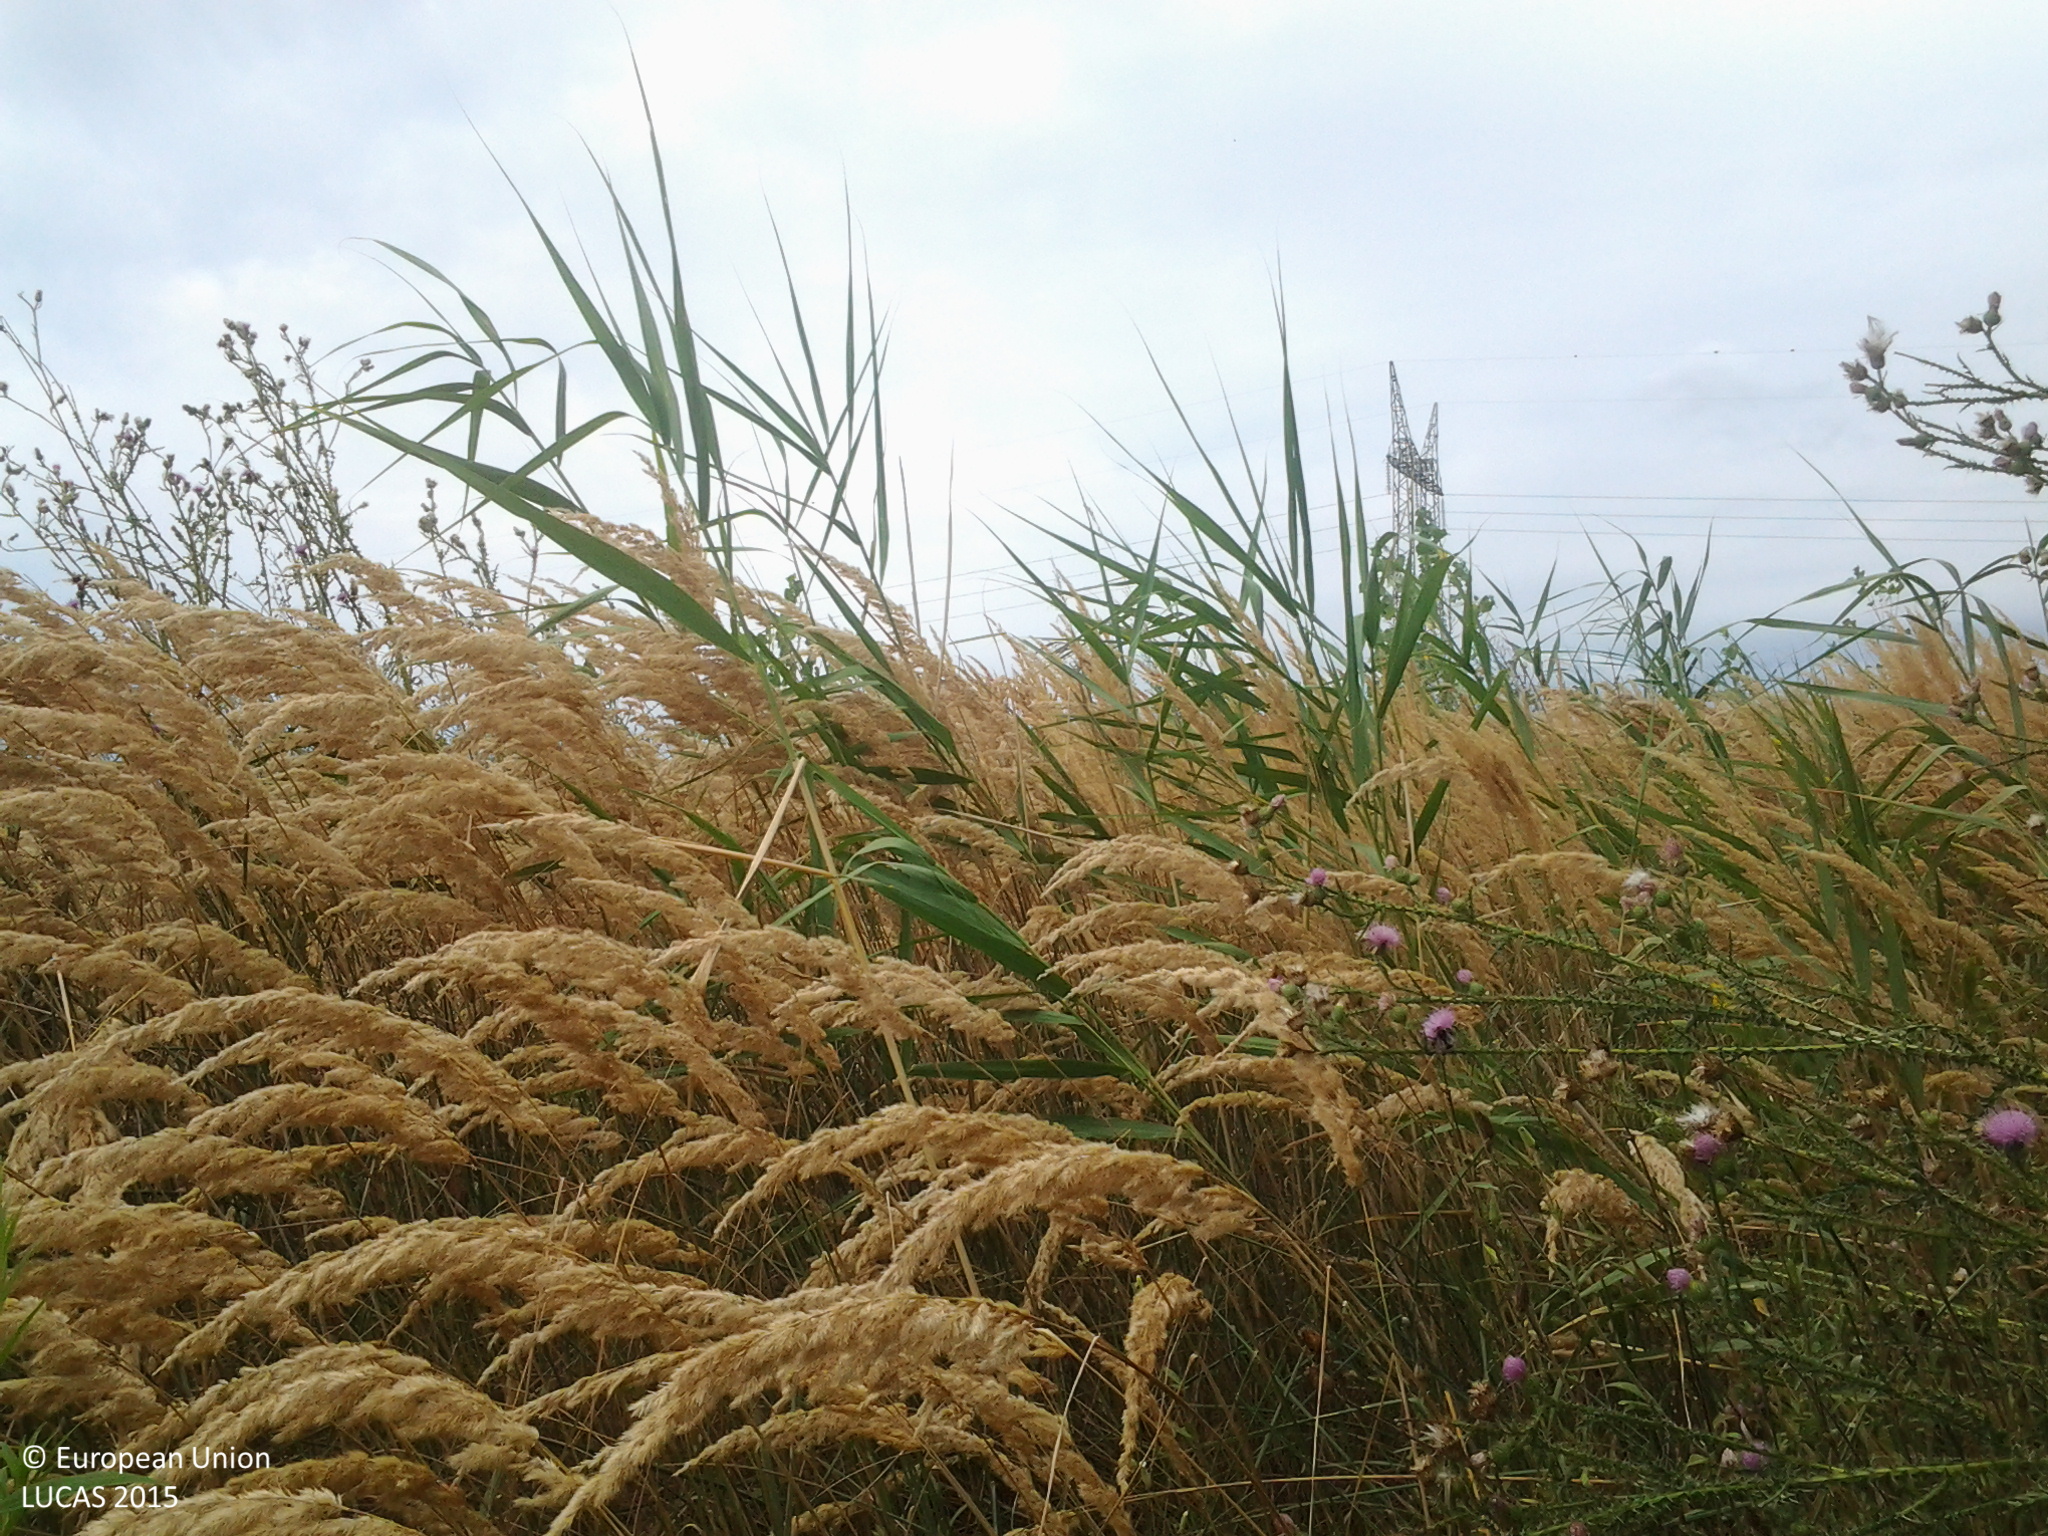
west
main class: Woodland
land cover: Broadleaved woodland
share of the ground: 50 - 75 %
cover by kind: broadleaved forest trees 70 %, herbaceous plants 20 %, shrubs 10 %
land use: Forestry
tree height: > 5 m
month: July
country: HU
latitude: 46.9882
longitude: 18.9693
